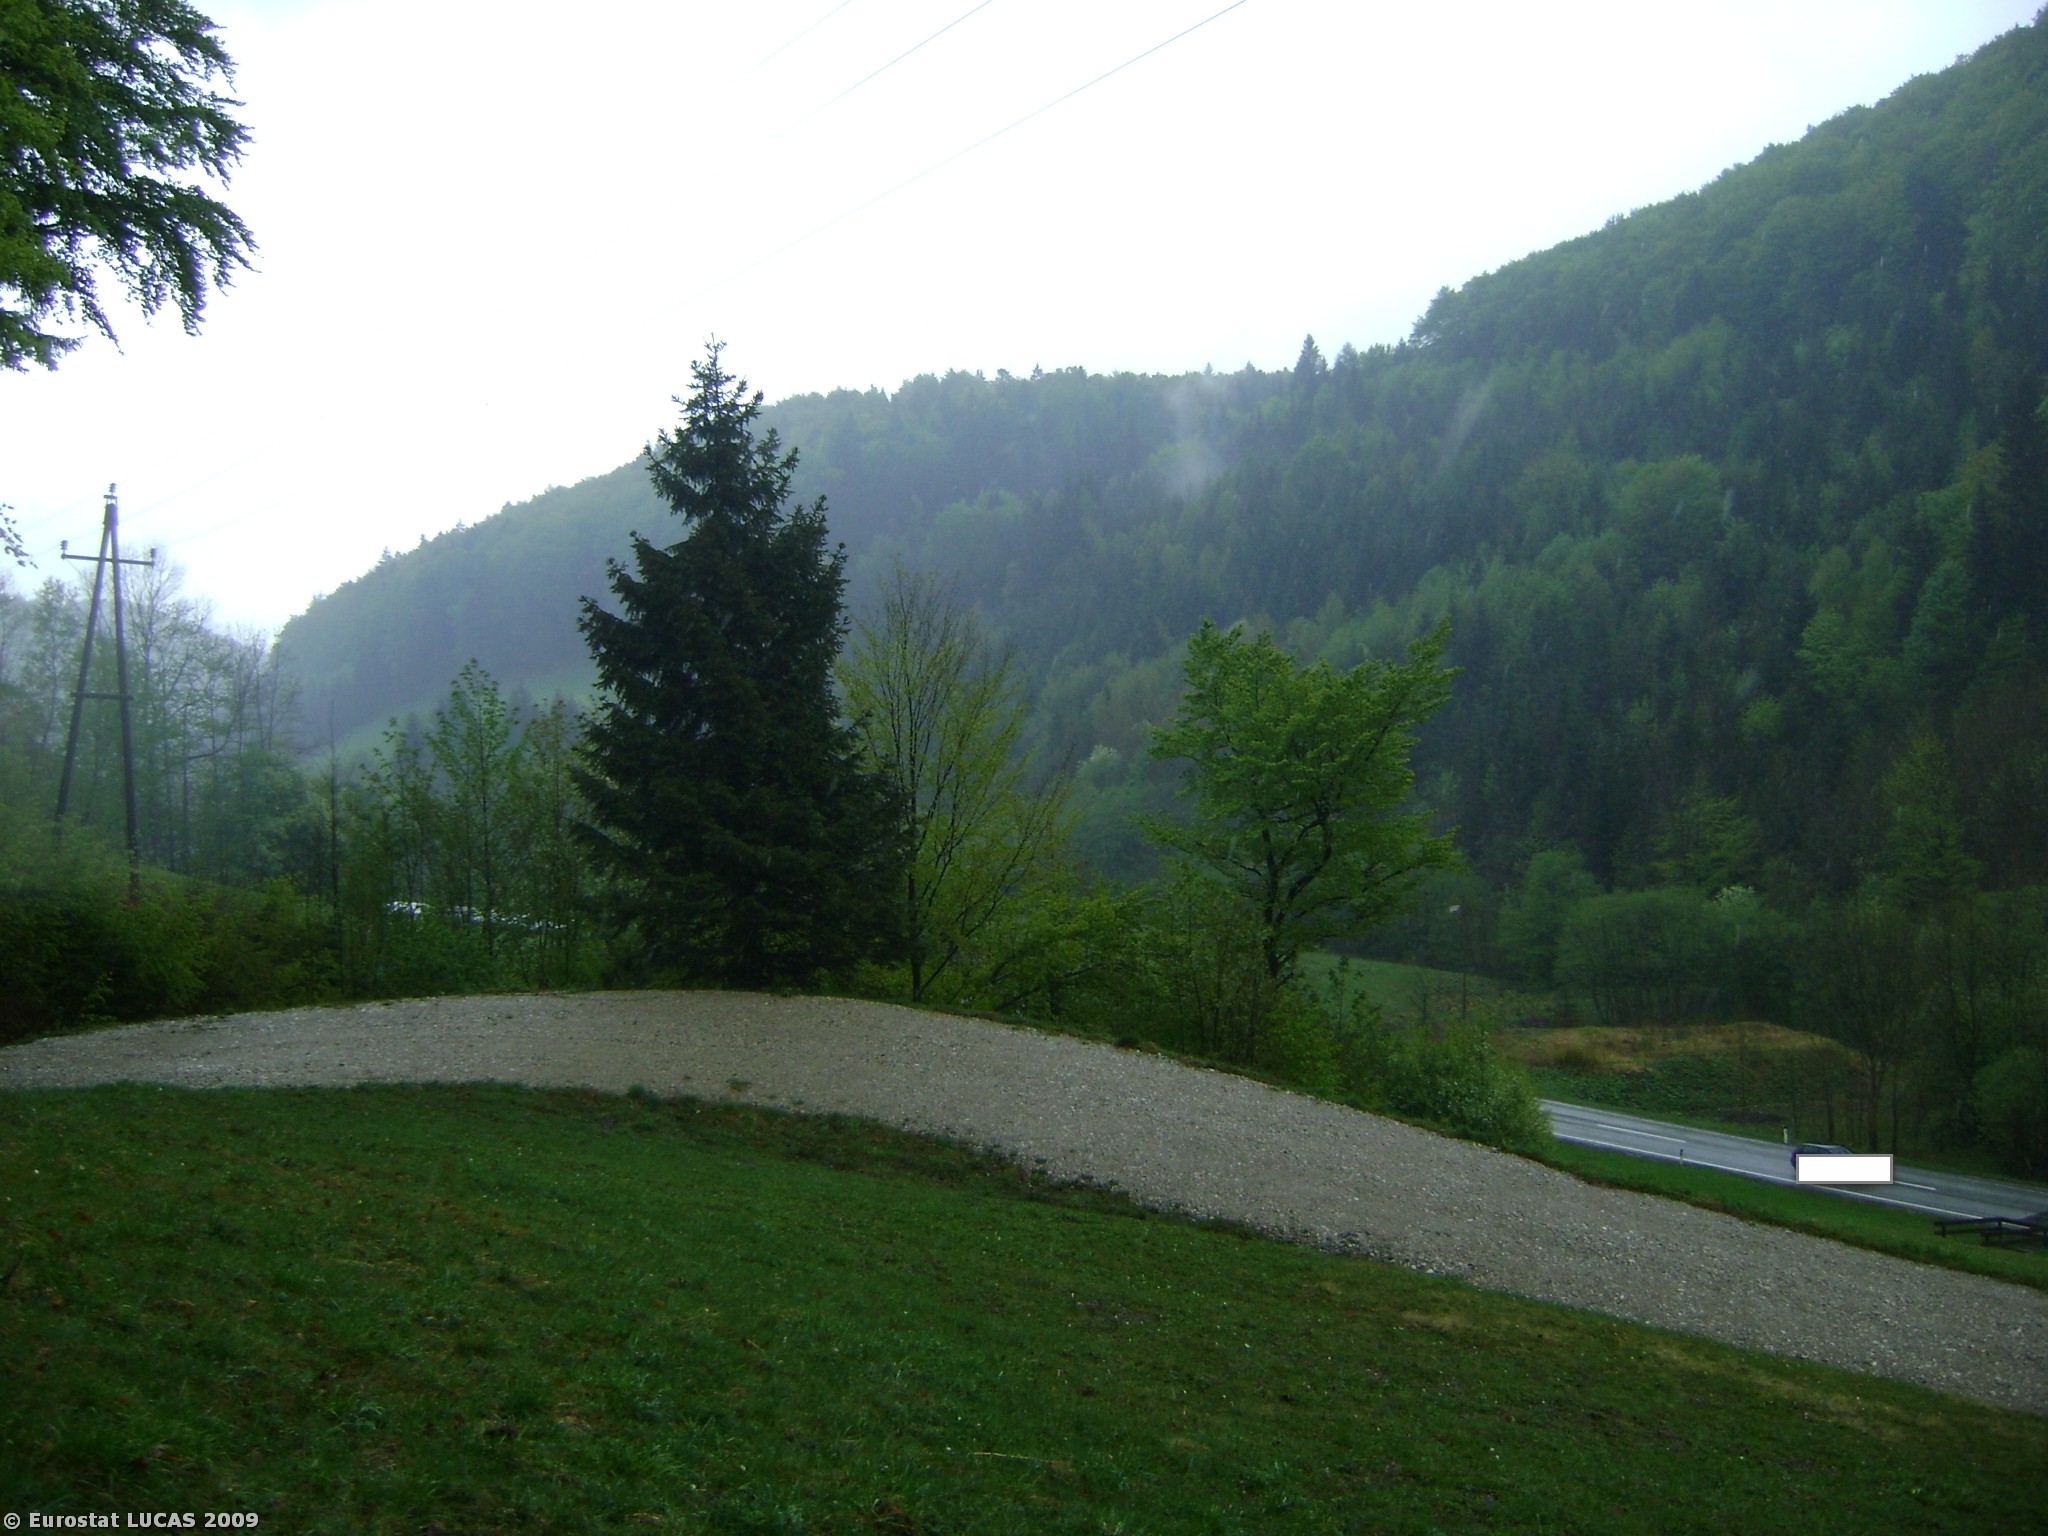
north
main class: Grassland
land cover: Grassland without tree/shrub cover
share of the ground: > 75 %
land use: Agriculture (excluding fallow land and kitchen gardens)
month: May
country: AT
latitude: 47.7976
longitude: 13.2429
